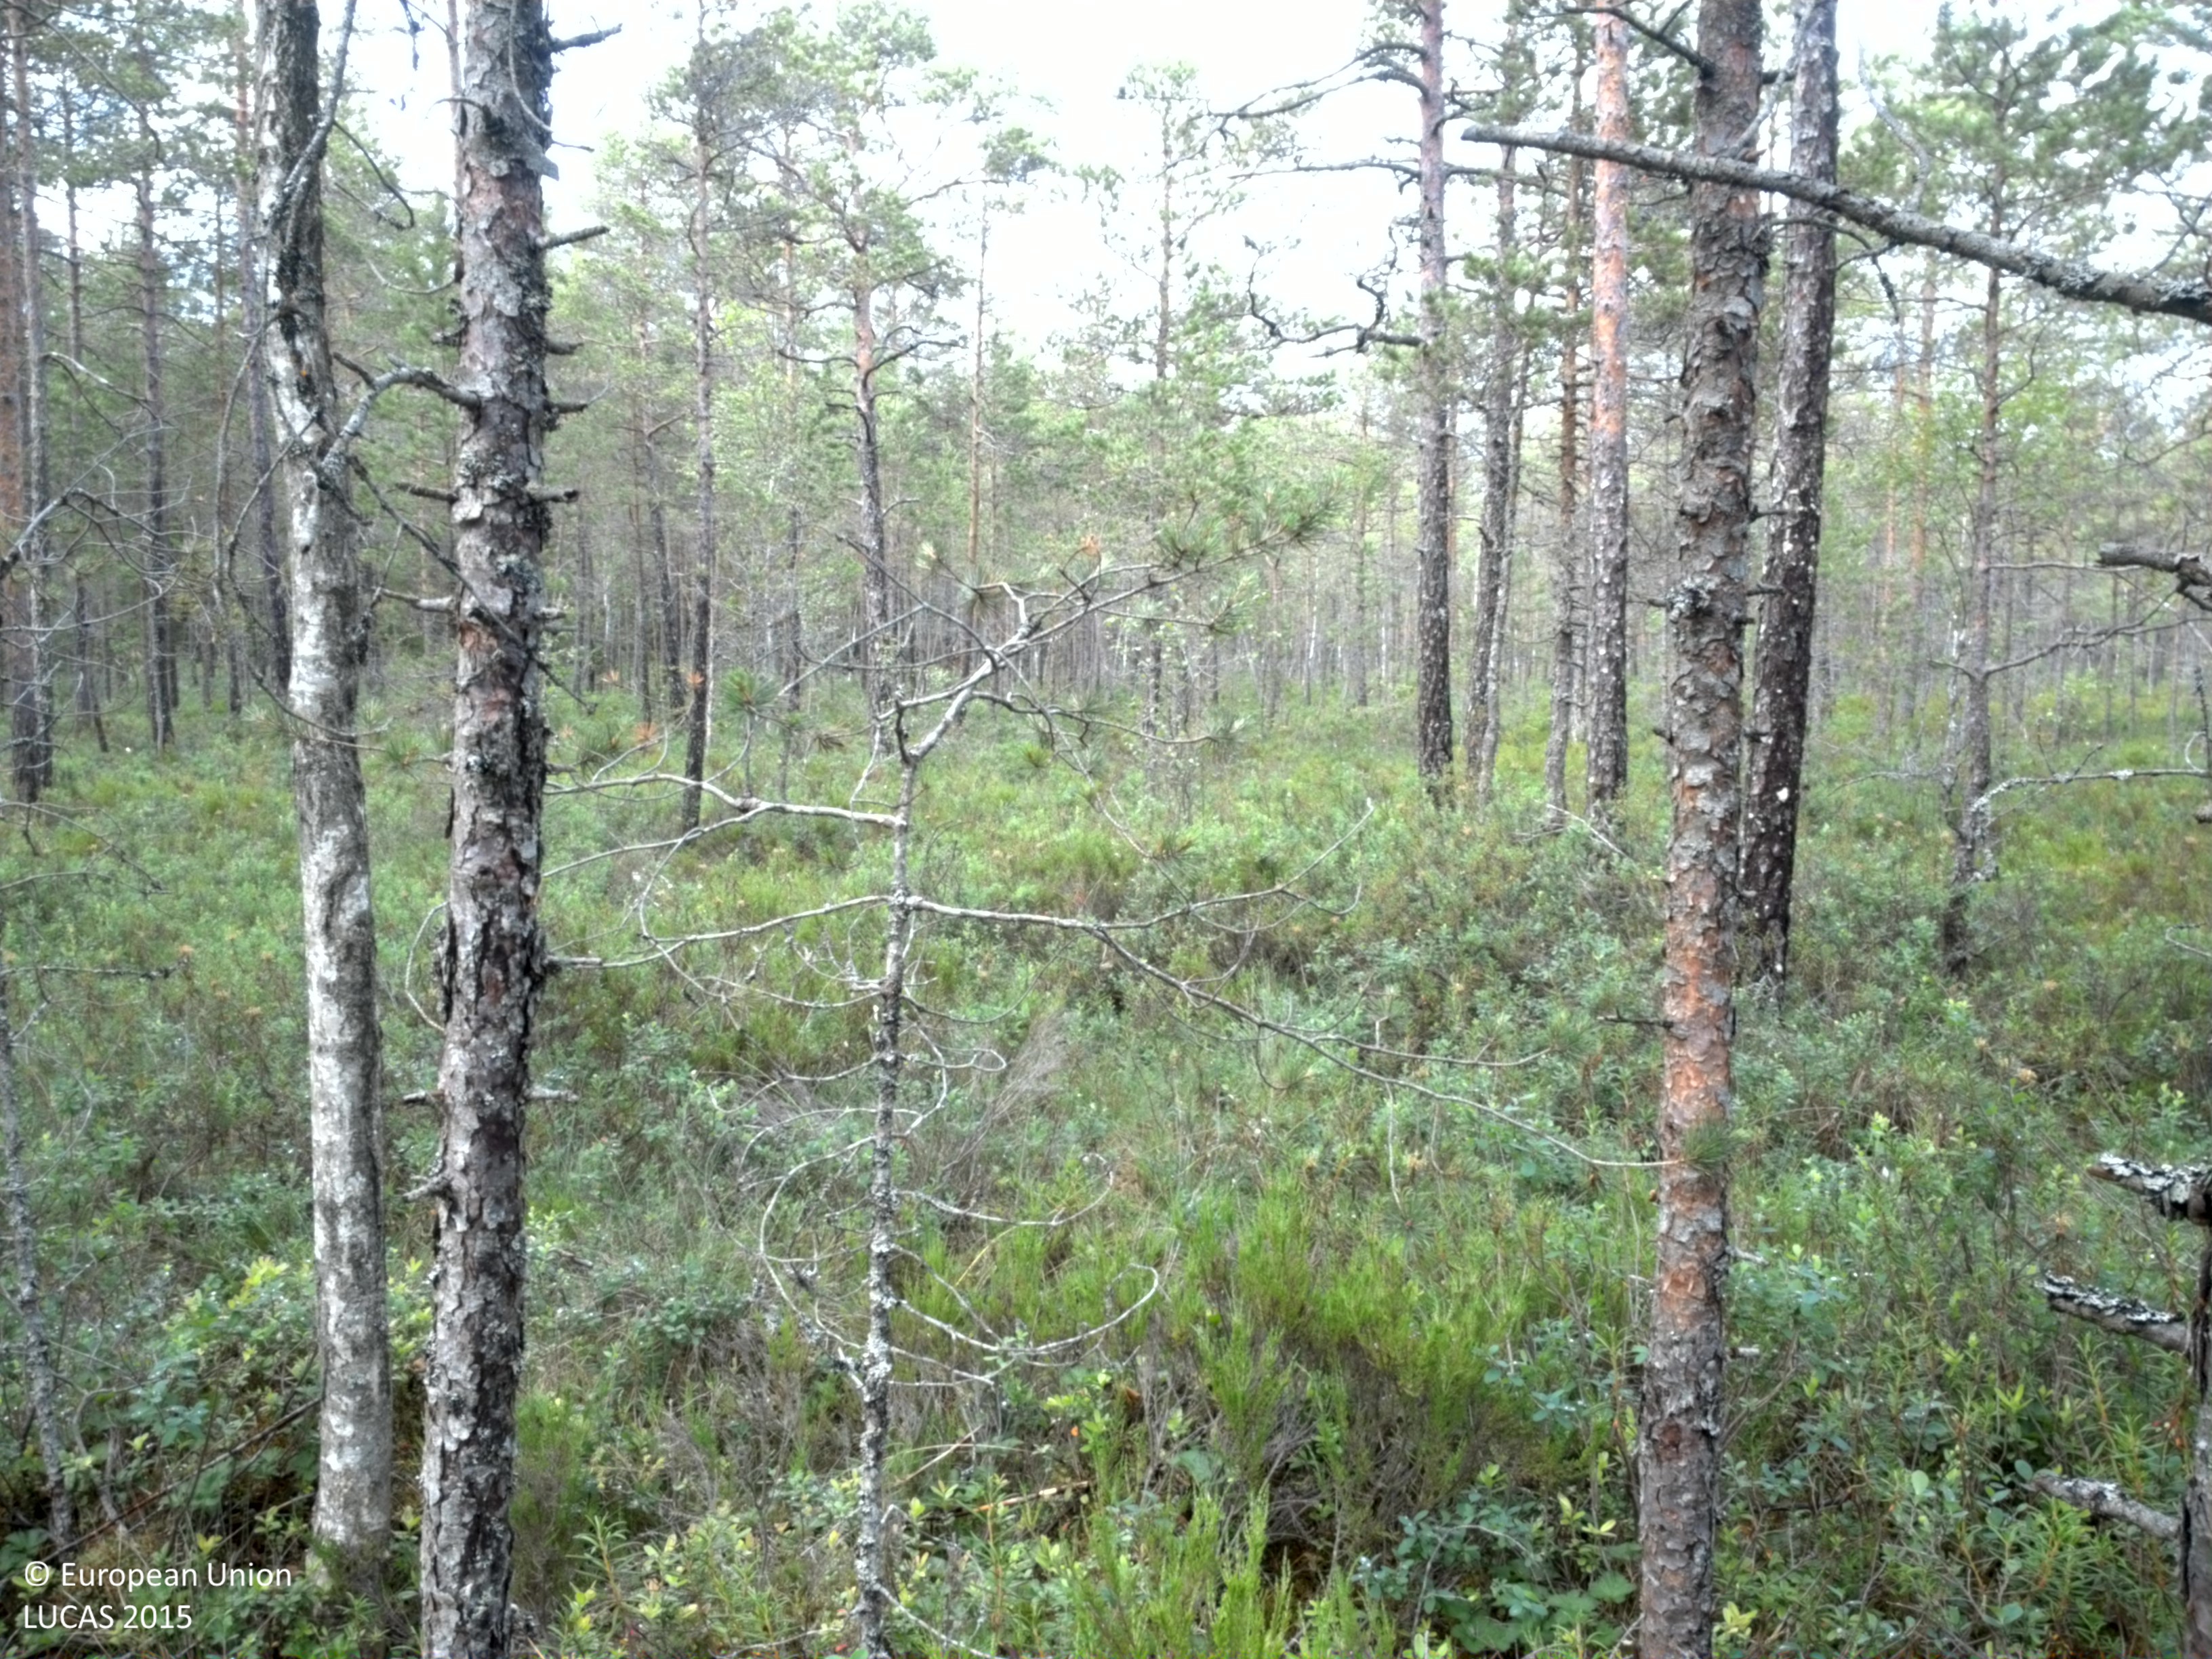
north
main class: Woodland
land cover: Pine dominated mixed woodland
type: mire and swamp forests
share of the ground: 50 - 75 %
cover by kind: coniferous forest trees 50 %, broadleaved forest trees 20 %, shrubs 20 %, herbaceous plants 5 %, lichens and mosses 5 %
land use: Forestry
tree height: > 5 m
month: July
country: SE
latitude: 59.4711
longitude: 14.7033
